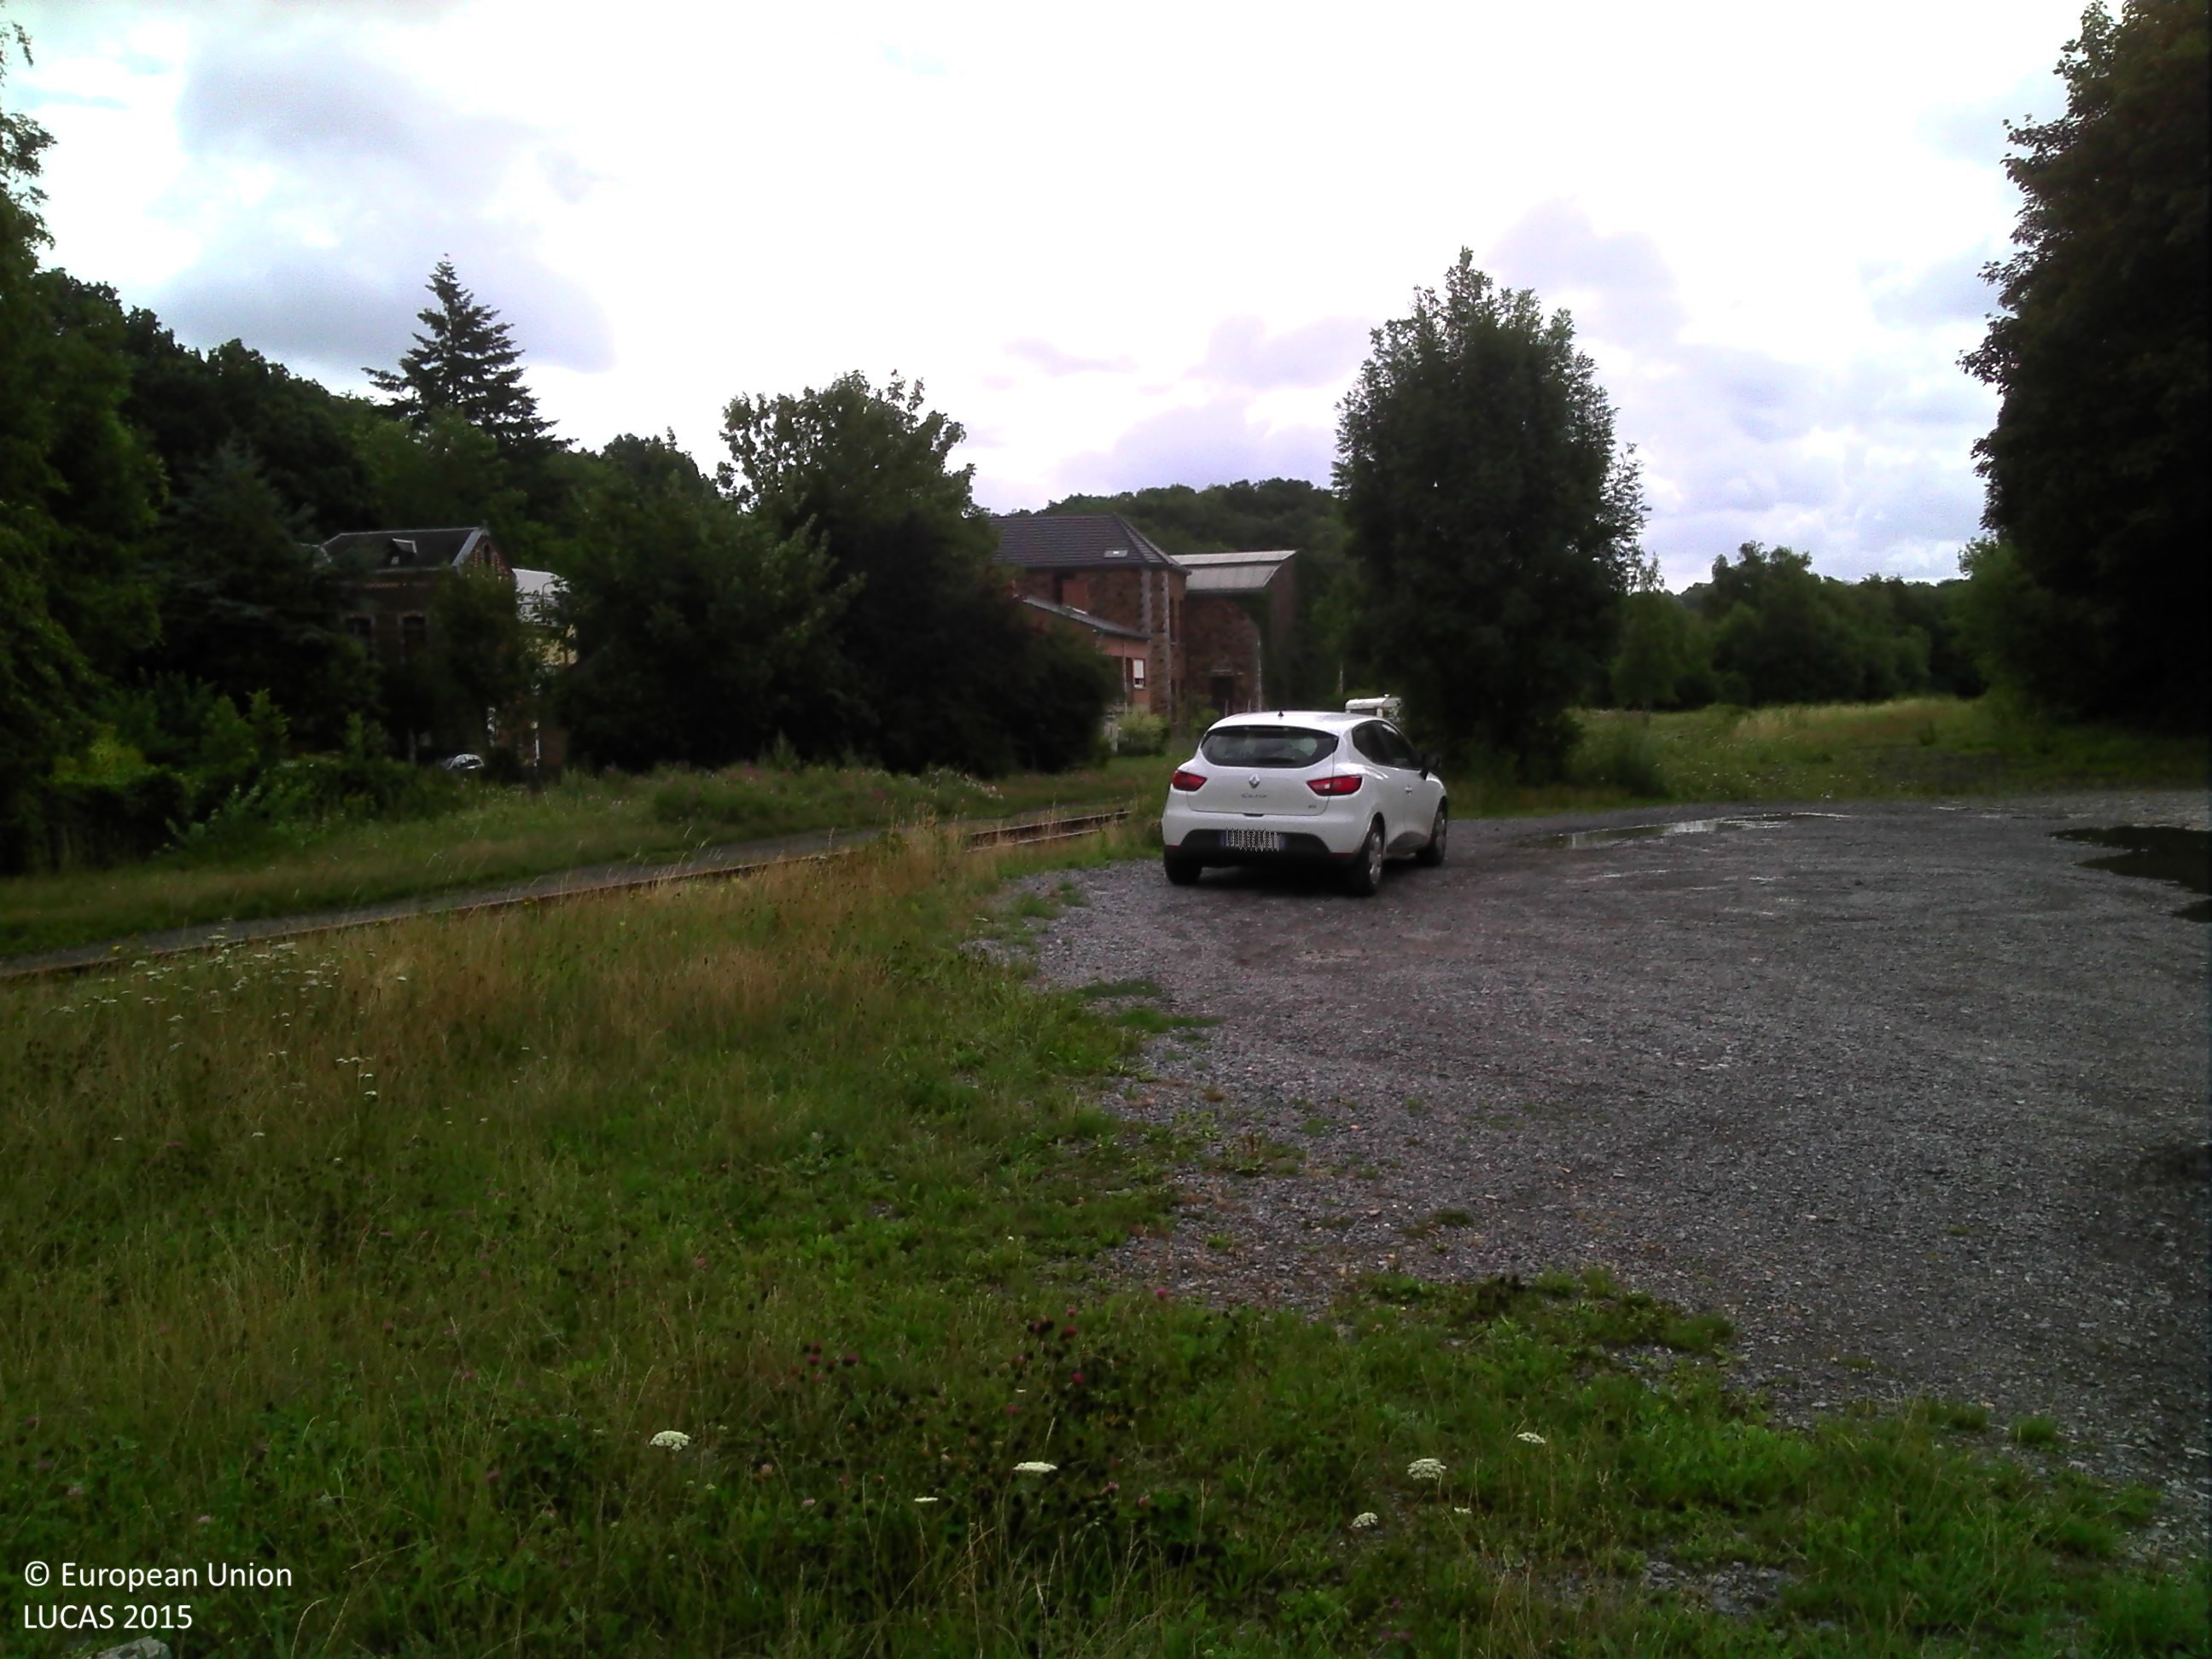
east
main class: Grassland
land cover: Grassland without tree/shrub cover
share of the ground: > 75 %
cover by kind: herbaceous plants 100 %
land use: Road transport
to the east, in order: Grassland without tree/shrub cover; Artificial constructions in urban areas
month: July
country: BE
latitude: 50.5509
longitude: 5.1848
